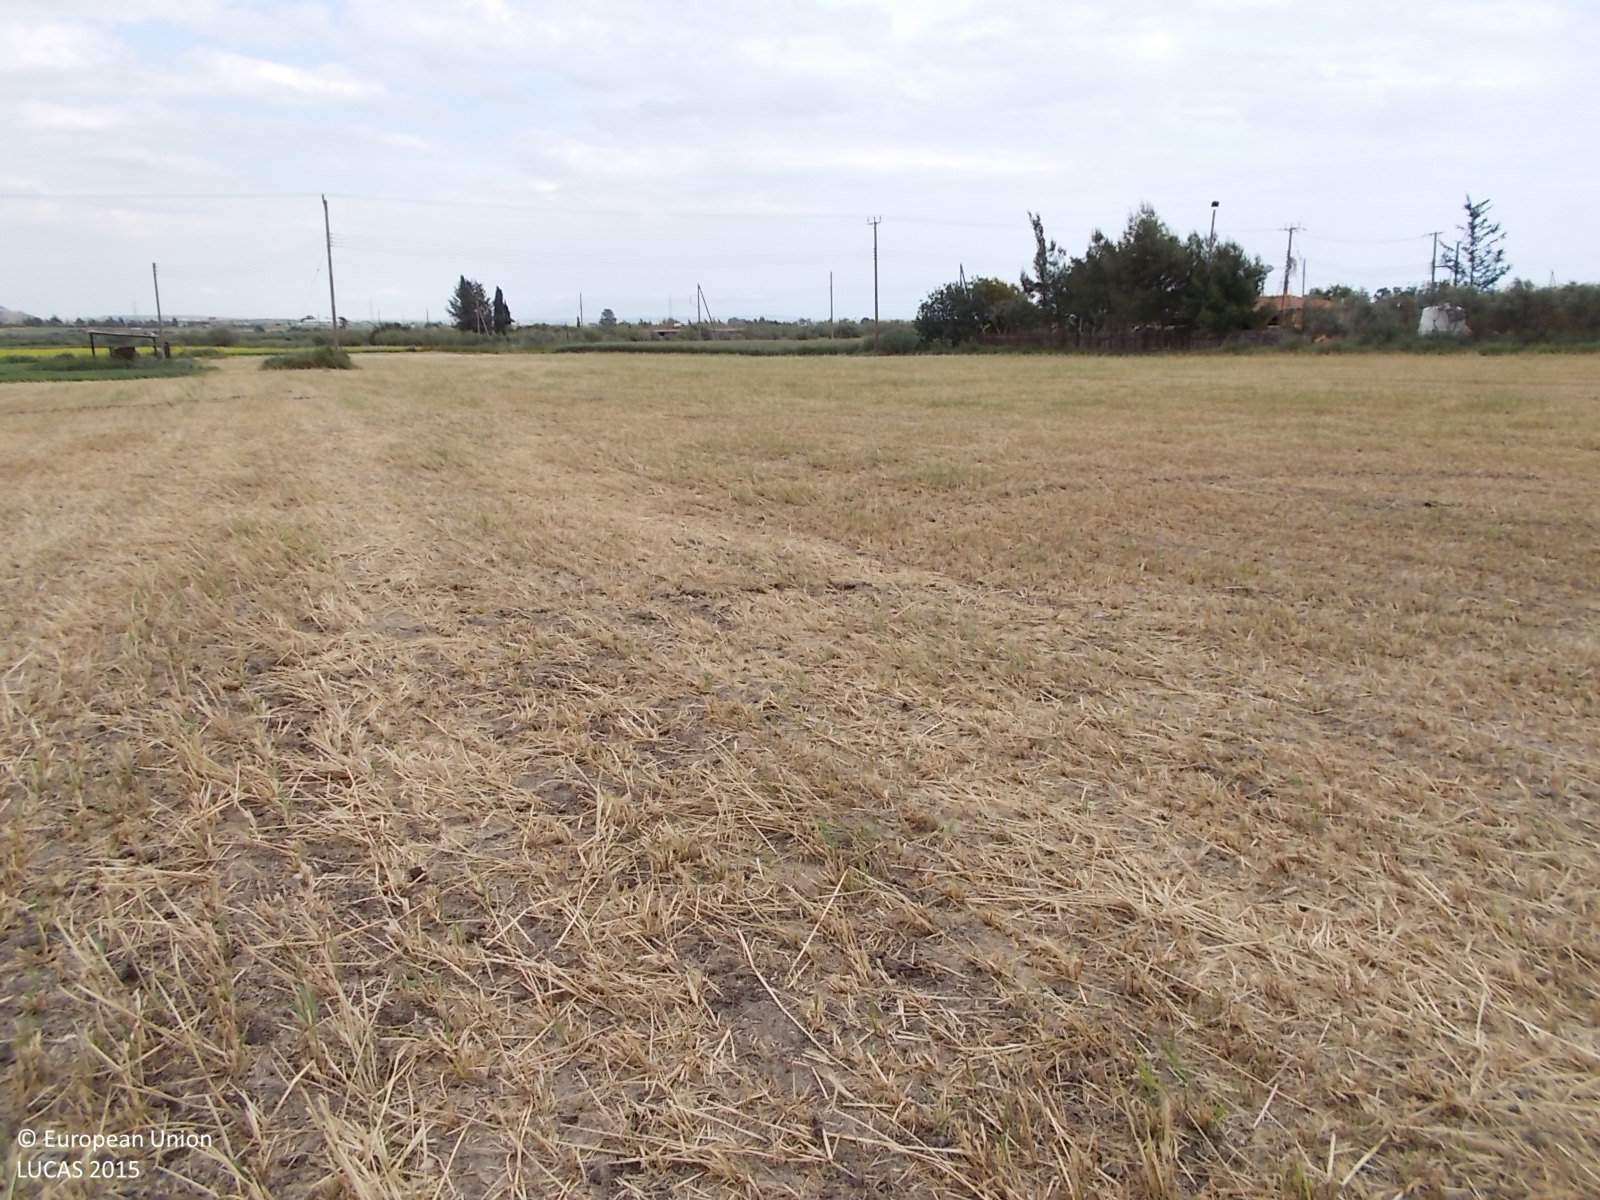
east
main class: Cropland
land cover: Common wheat
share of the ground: < 10 %
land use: Agriculture (excluding fallow land and kitchen gardens)
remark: Harvested field
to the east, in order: Common wheat; Electric lines; Common wheat; Grass margins; Paved roads, cycling and walking lanes; Electric lines; Grass margins; Olive groves; Spontaneously vegetated surfaces; Artificial constructions in urban areas
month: April
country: CY
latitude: 34.9578
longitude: 33.5992
